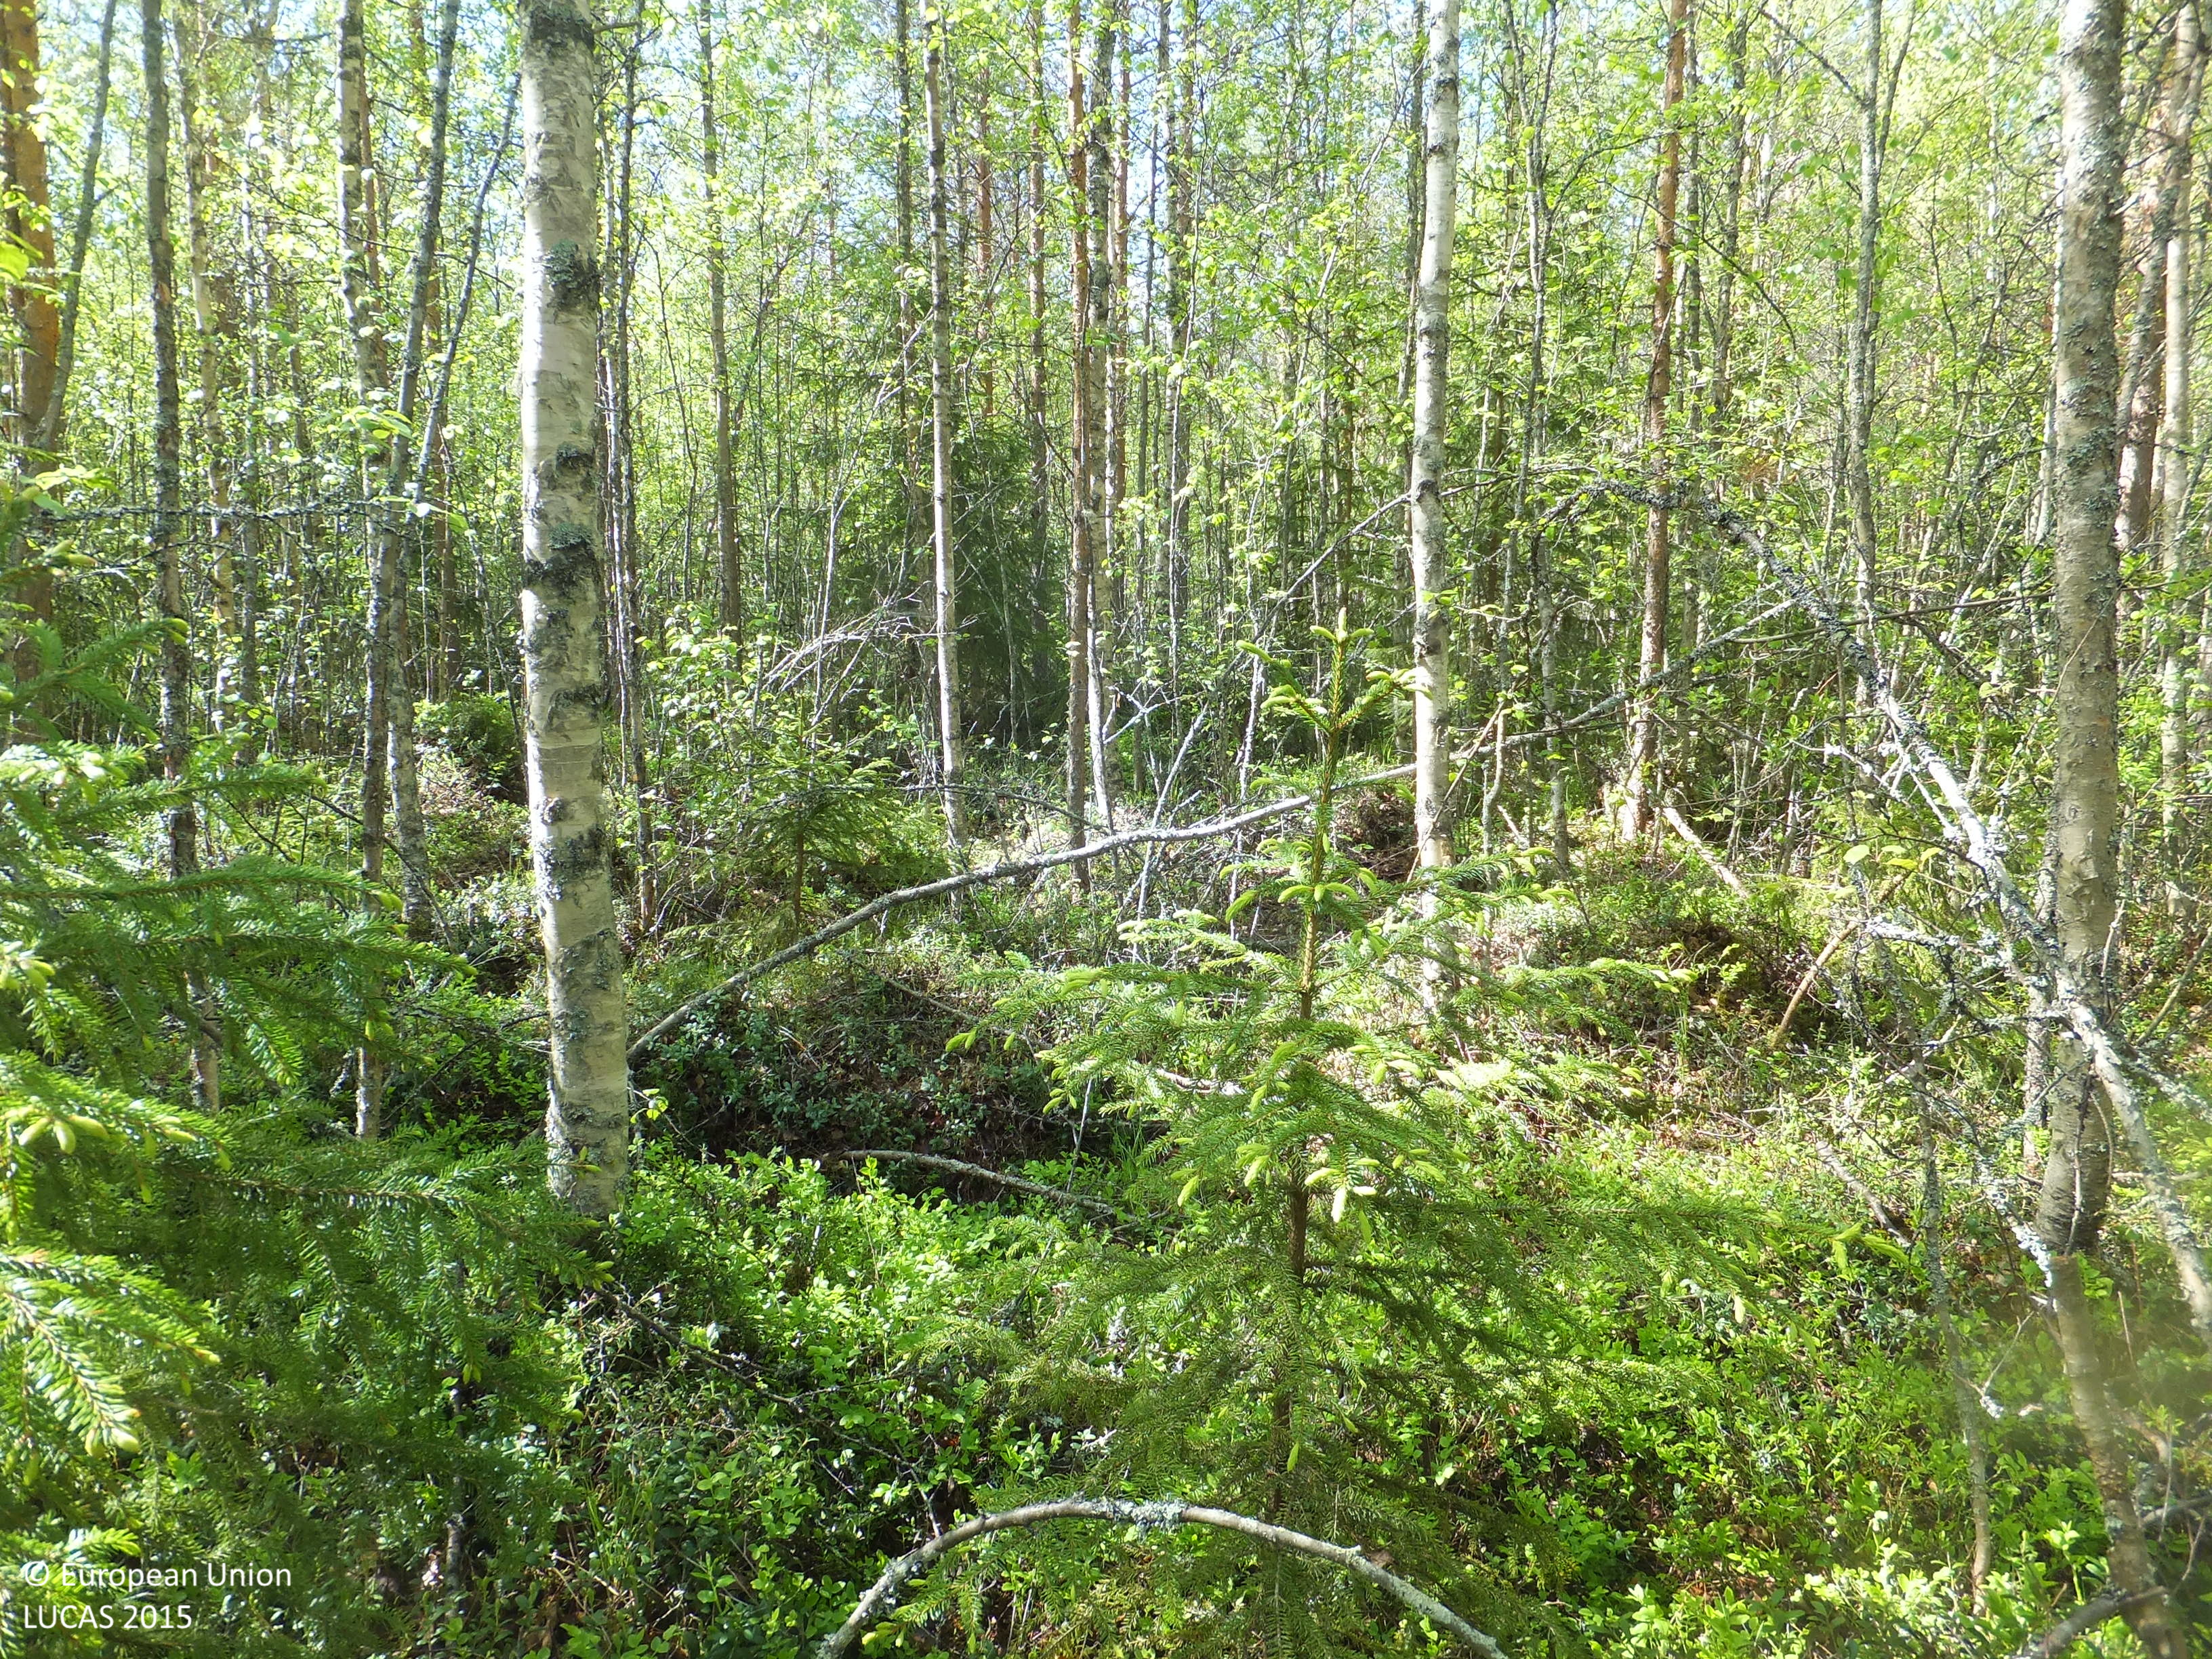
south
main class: Woodland
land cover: Spruce dominated mixed woodland
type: boreal forest
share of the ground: > 75 %
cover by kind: broadleaved forest trees 60 %, coniferous forest trees 30 %, shrubs 10 %
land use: Forestry
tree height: > 5 m
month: June
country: FI
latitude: 63.5915
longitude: 22.9296
